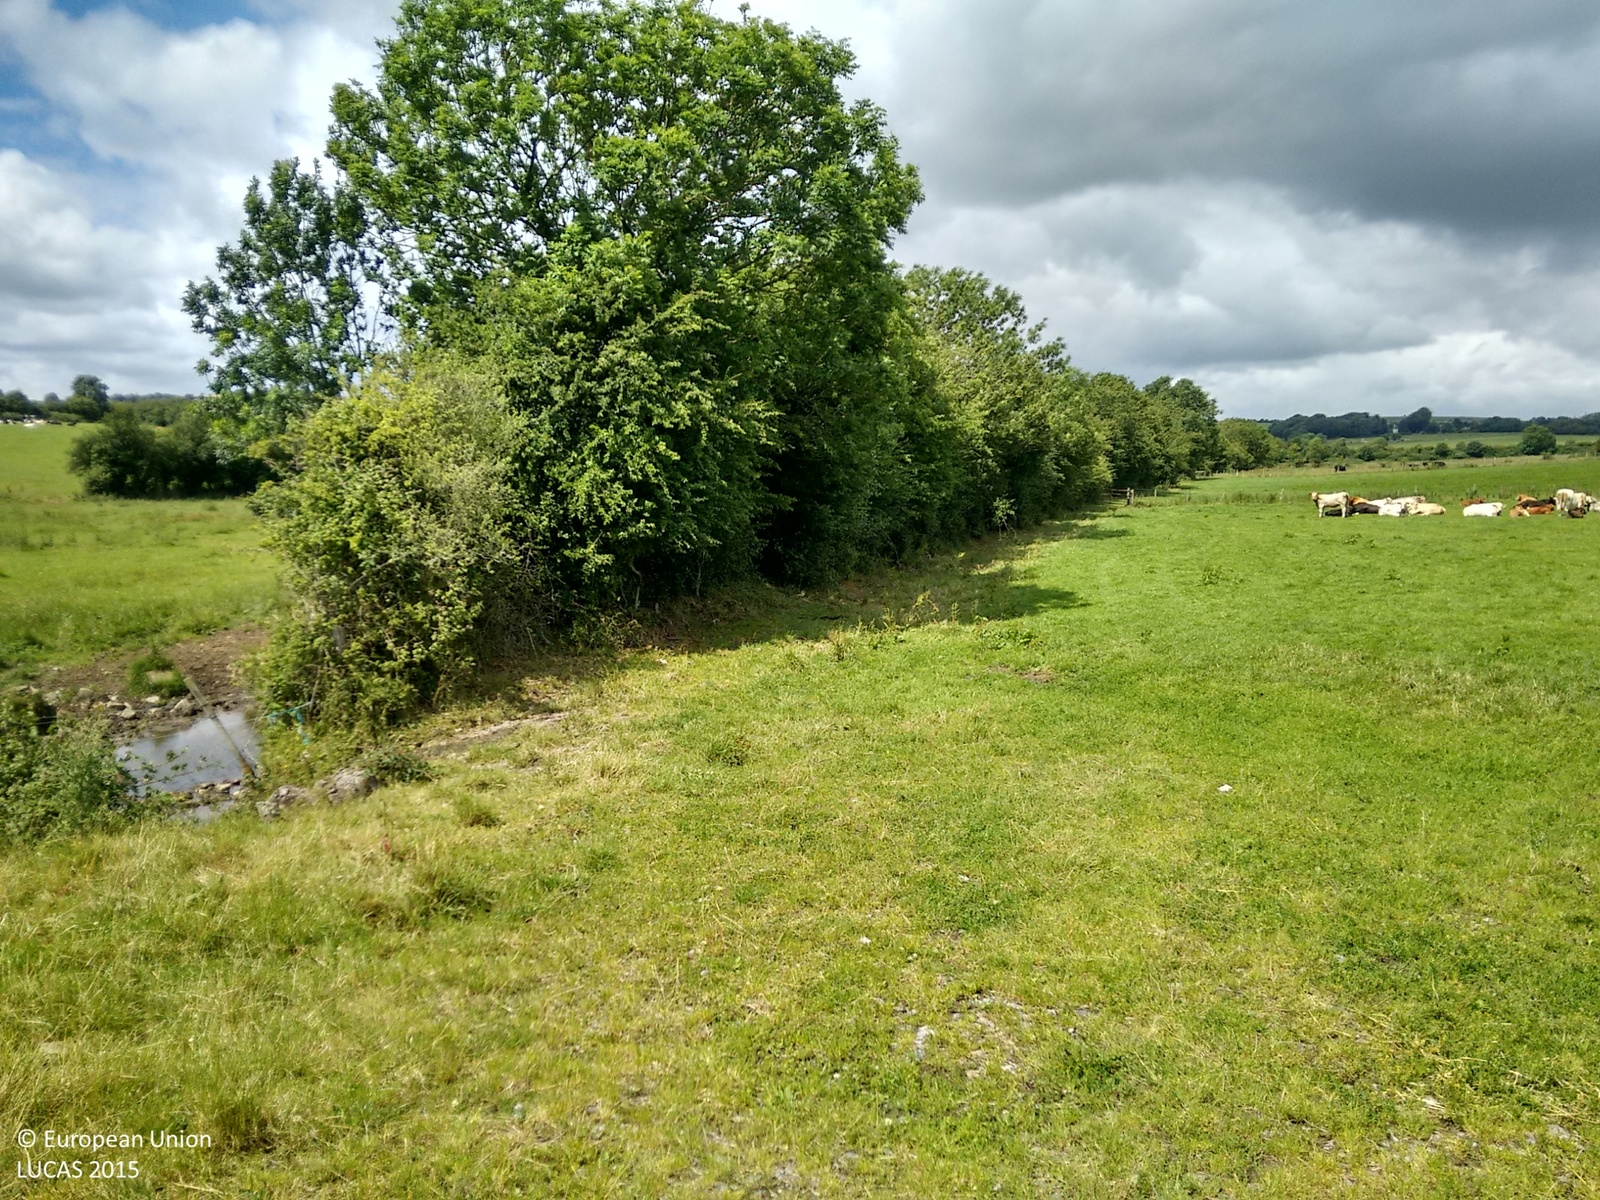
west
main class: Grassland
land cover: Grassland without tree/shrub cover
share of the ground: > 75 %
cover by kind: herbaceous plants 100 %
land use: Agriculture (excluding fallow land and kitchen gardens)
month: July
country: IE
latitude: 52.7646
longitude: -7.4522
